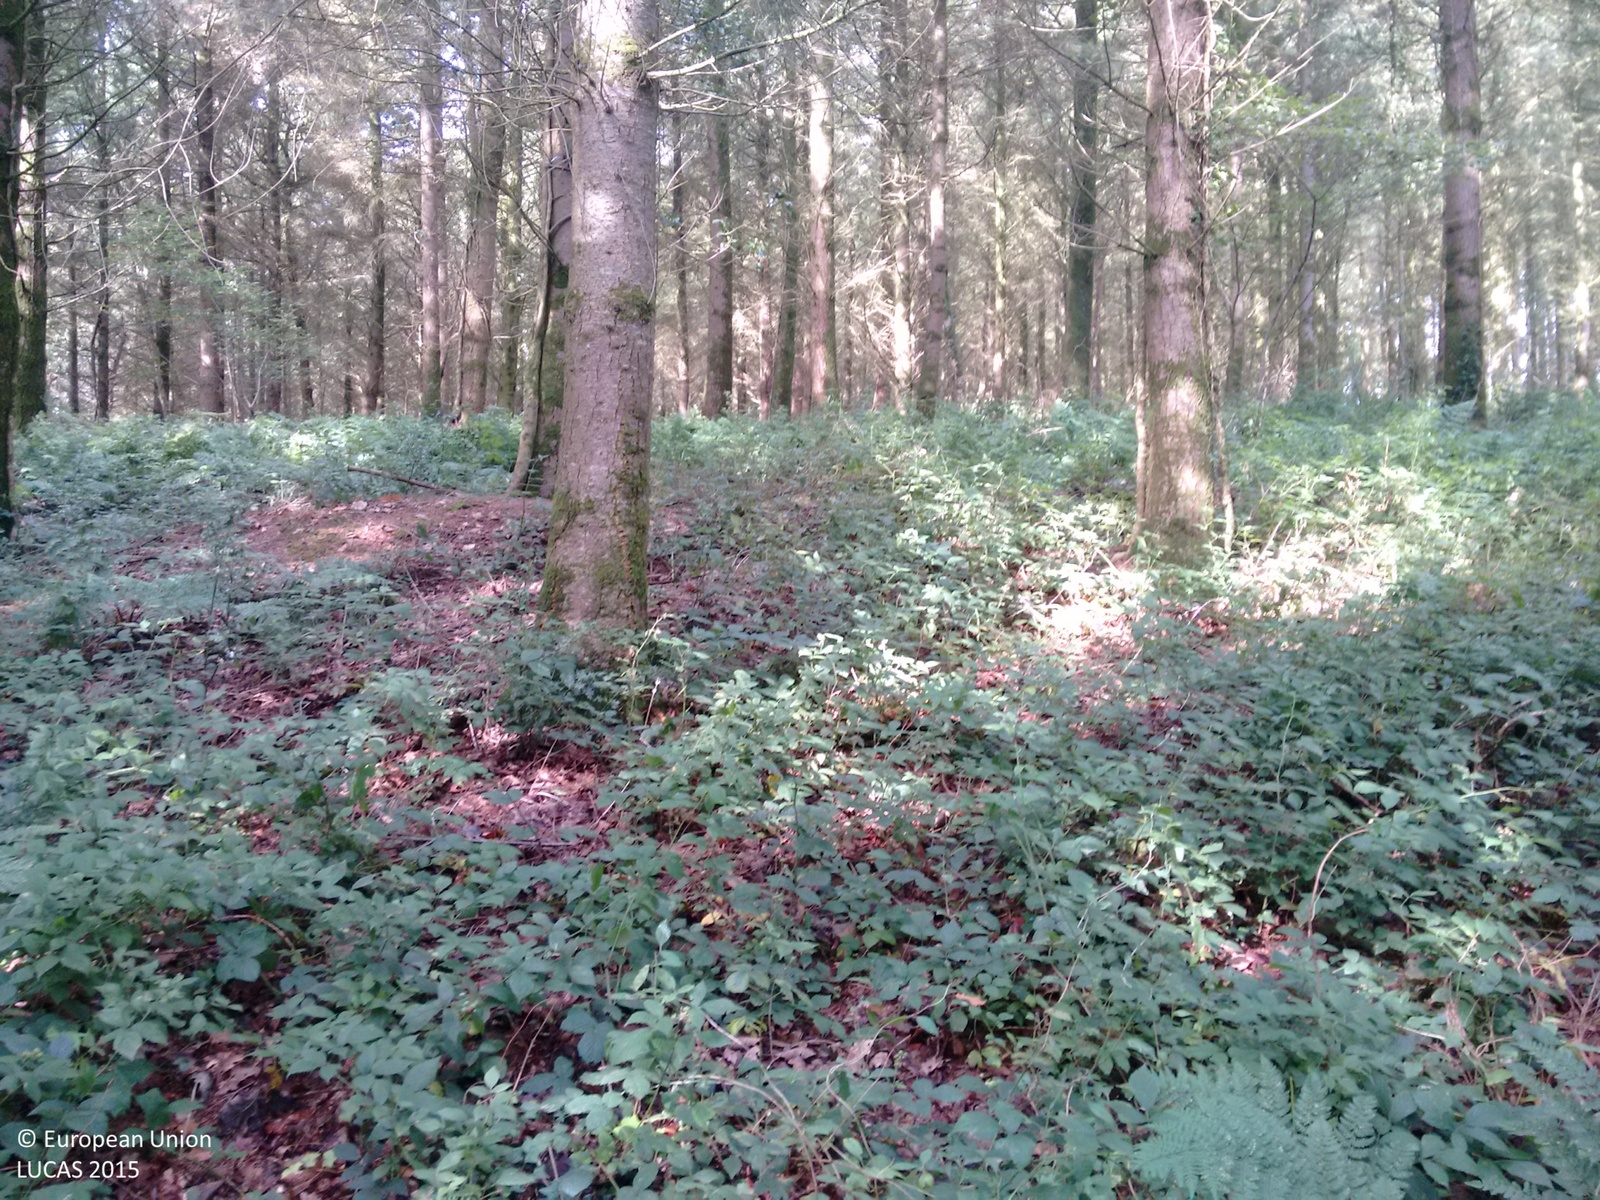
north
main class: Woodland
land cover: Spruce dominated mixed woodland
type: exotic forest
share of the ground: > 75 %
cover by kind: coniferous forest trees 60 %, broadleaved forest trees 40 %
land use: Forestry
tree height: > 5 m
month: September
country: GB
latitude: 50.7296
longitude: -4.3683
